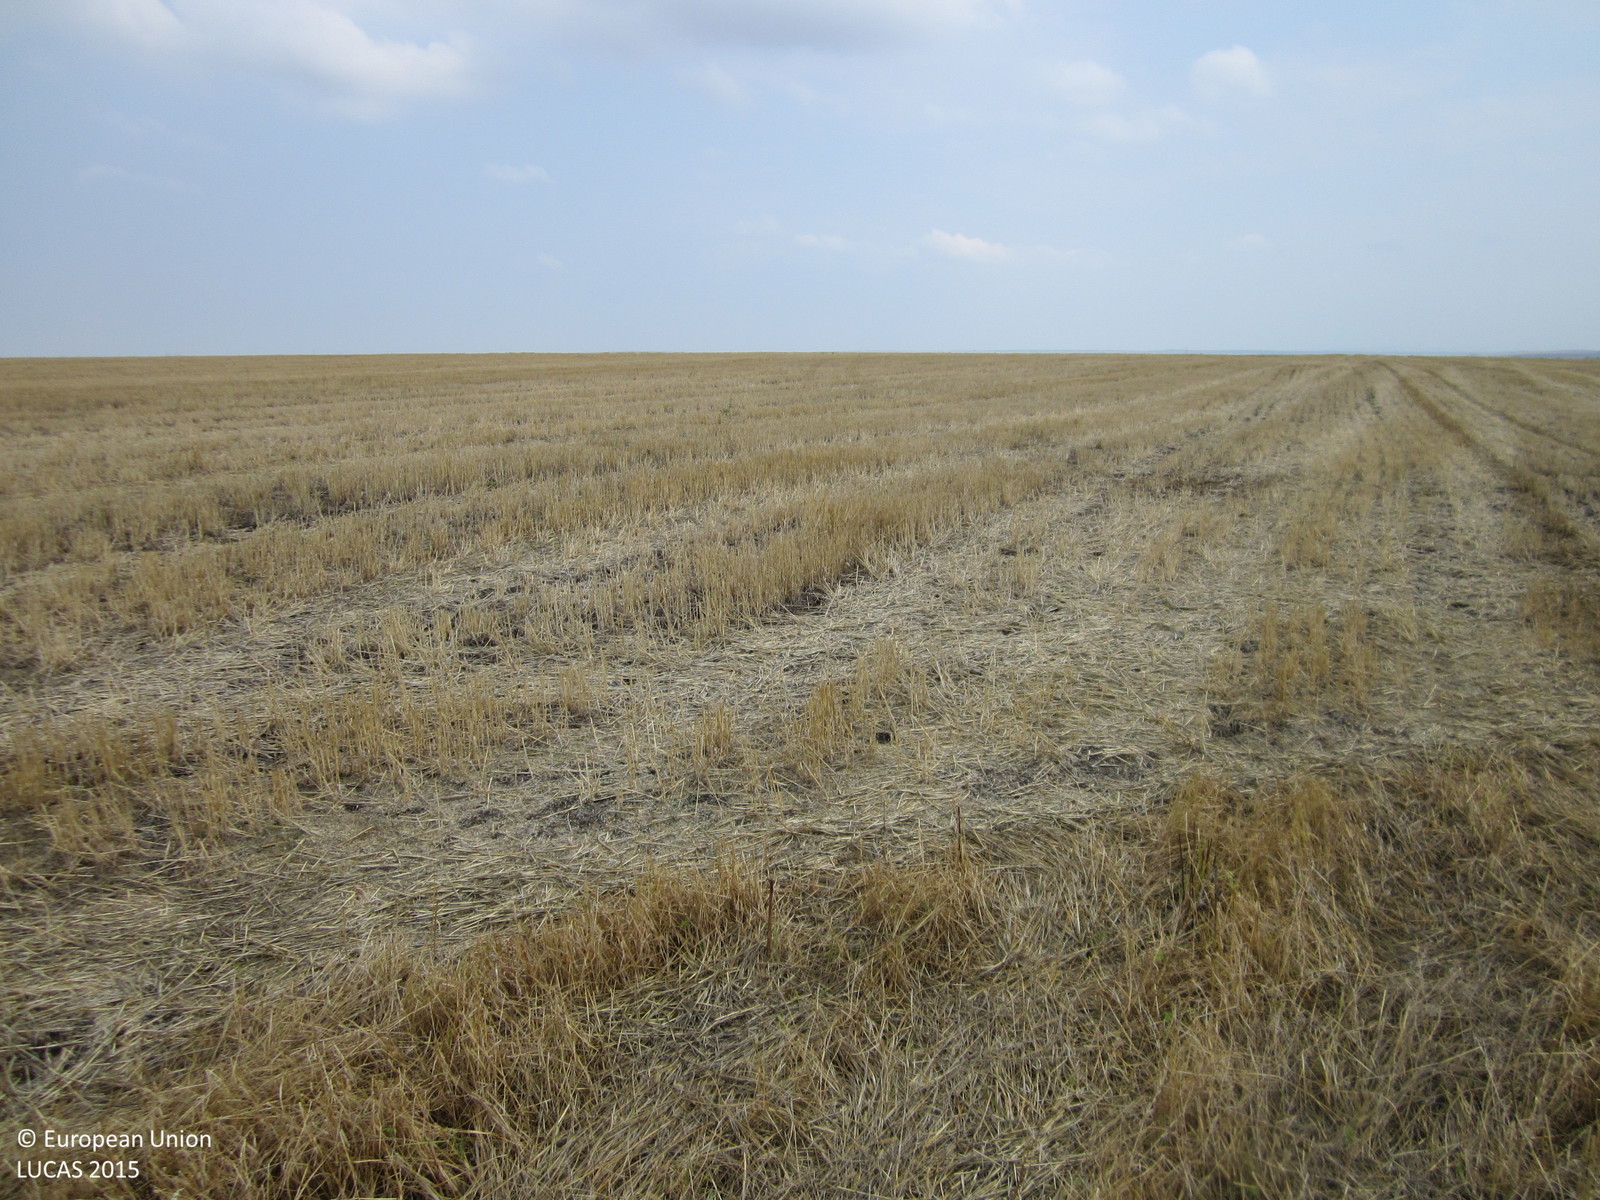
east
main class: Cropland
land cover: Common wheat
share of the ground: 50 - 75 %
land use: Agriculture (excluding fallow land and kitchen gardens)
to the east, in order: Common wheat
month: August
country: BG
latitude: 42.5399
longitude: 26.9435
